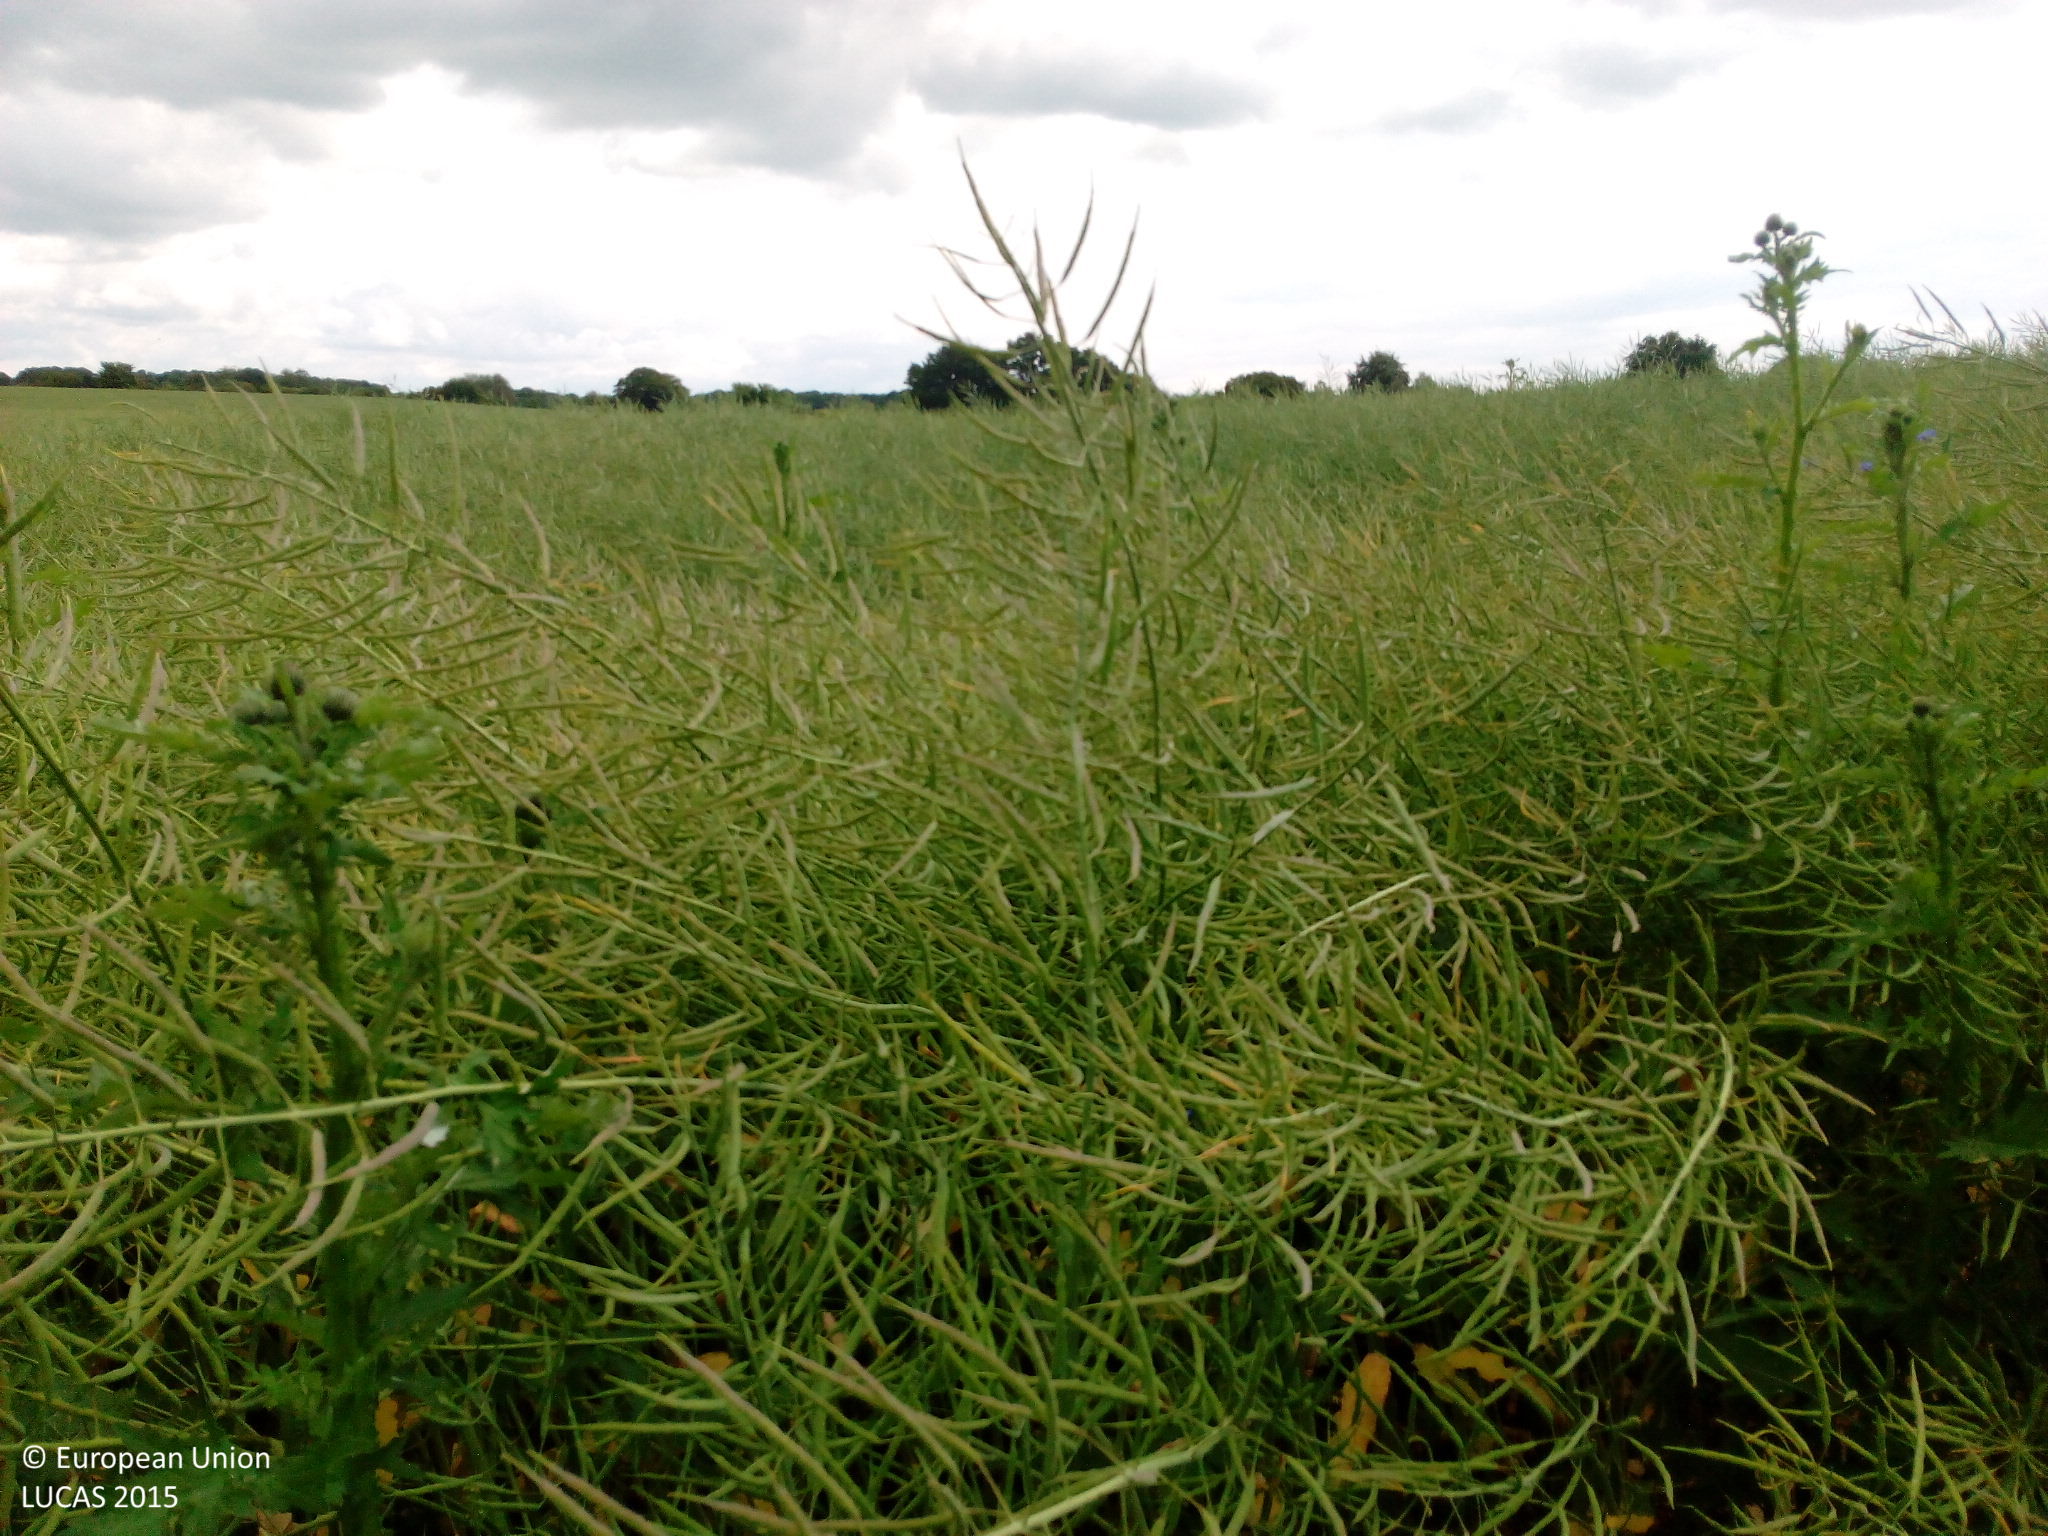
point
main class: Cropland
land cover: Rape and turnip rape
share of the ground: > 75 %
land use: Agriculture (excluding fallow land and kitchen gardens)
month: June
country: DE
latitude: 53.8277
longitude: 11.1693
